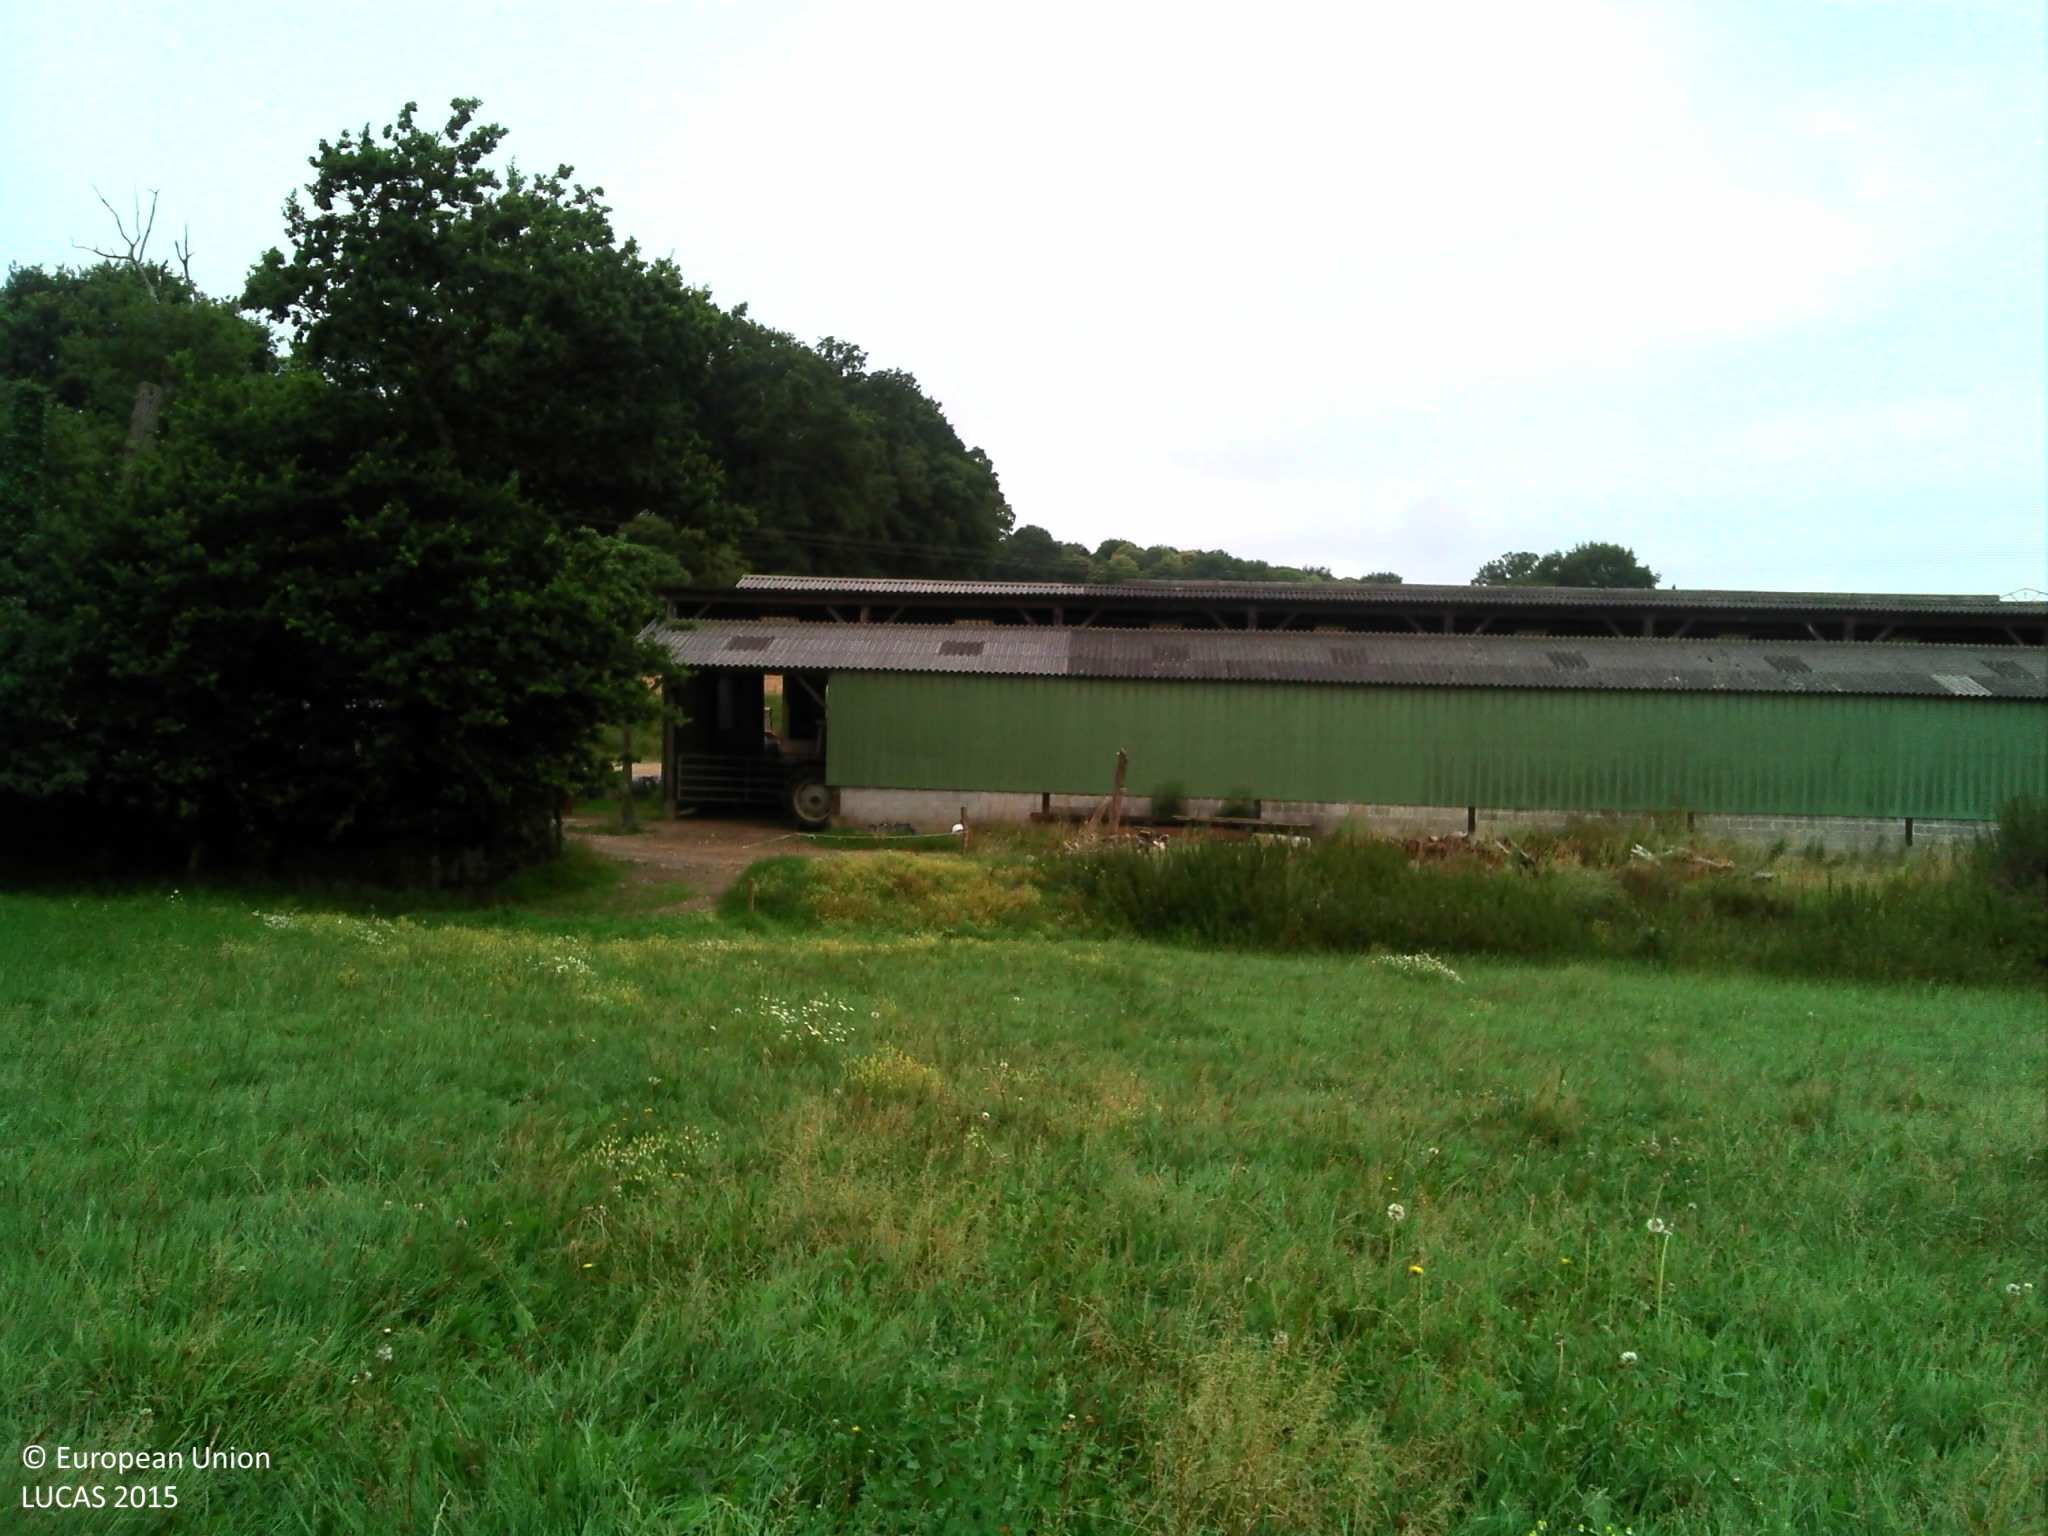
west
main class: Grassland
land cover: Grassland without tree/shrub cover
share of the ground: > 75 %
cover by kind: herbaceous plants 100 %
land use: Agriculture (excluding fallow land and kitchen gardens)
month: July
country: FR
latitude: 48.2555
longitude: -1.6723
